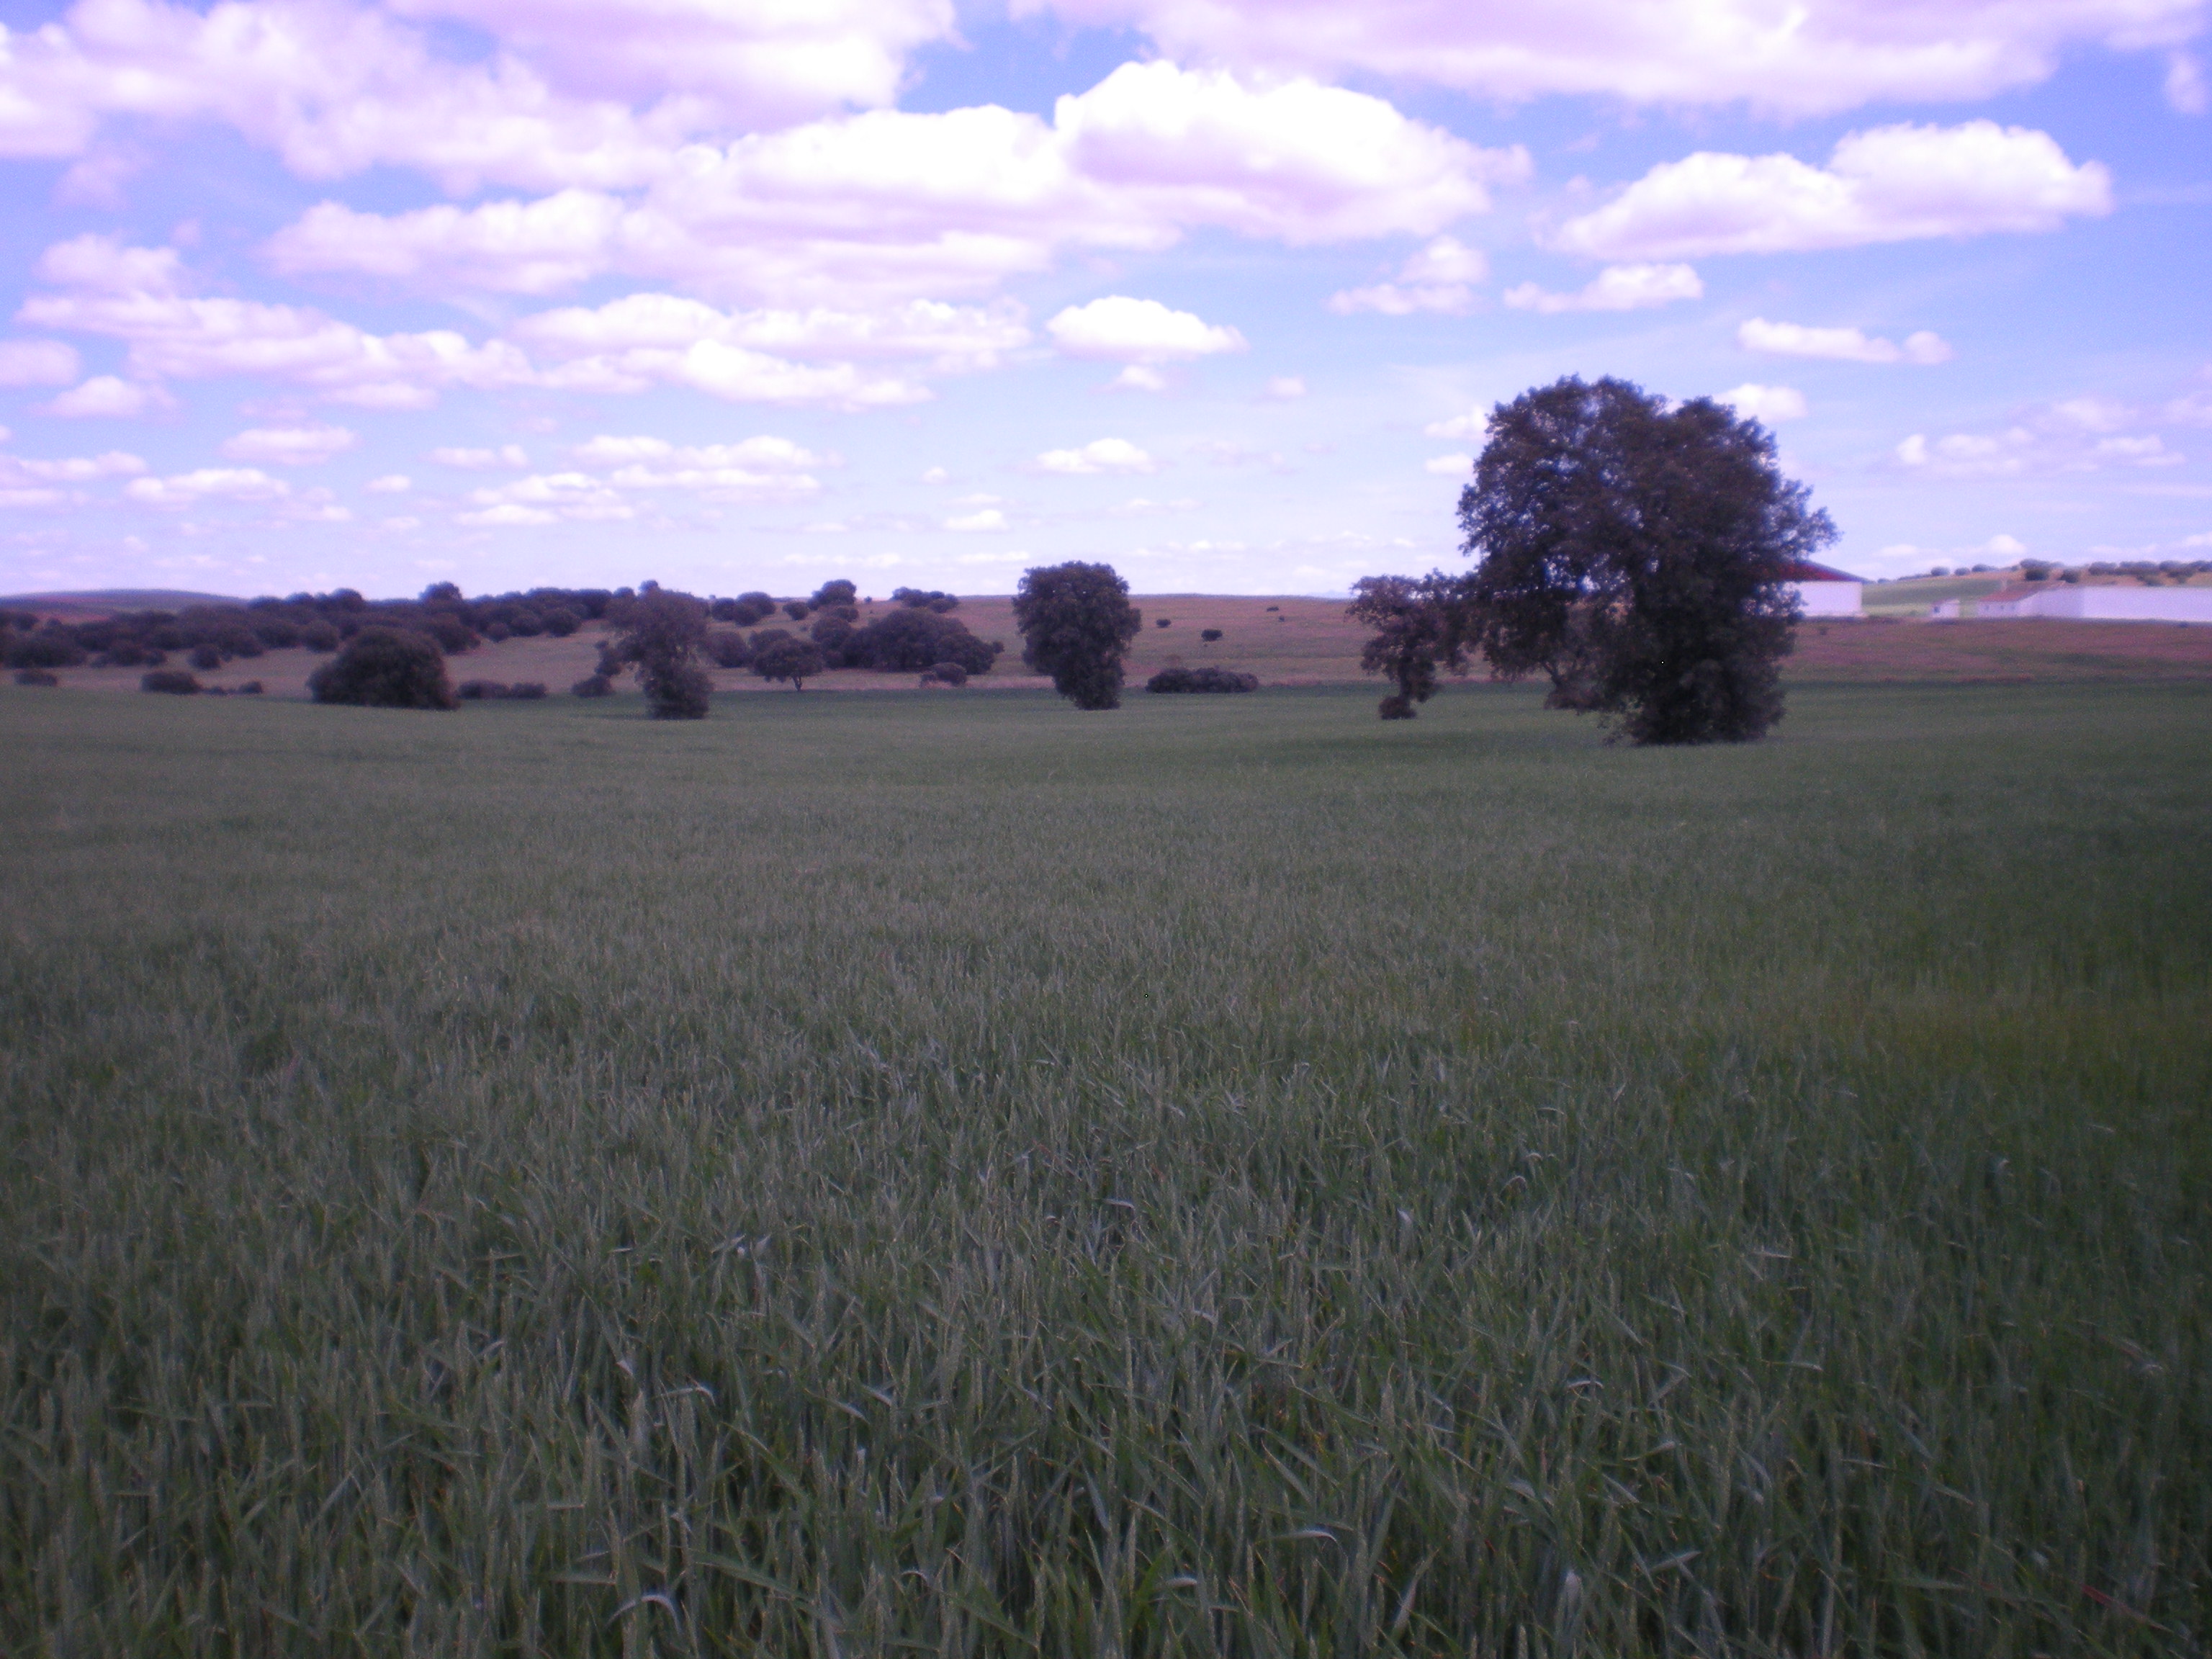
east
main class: Cropland
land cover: Common wheat
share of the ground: > 75 %
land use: Agriculture (excluding fallow land and kitchen gardens)
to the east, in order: Common wheat
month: April
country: ES
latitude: 38.6259
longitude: -3.1587
